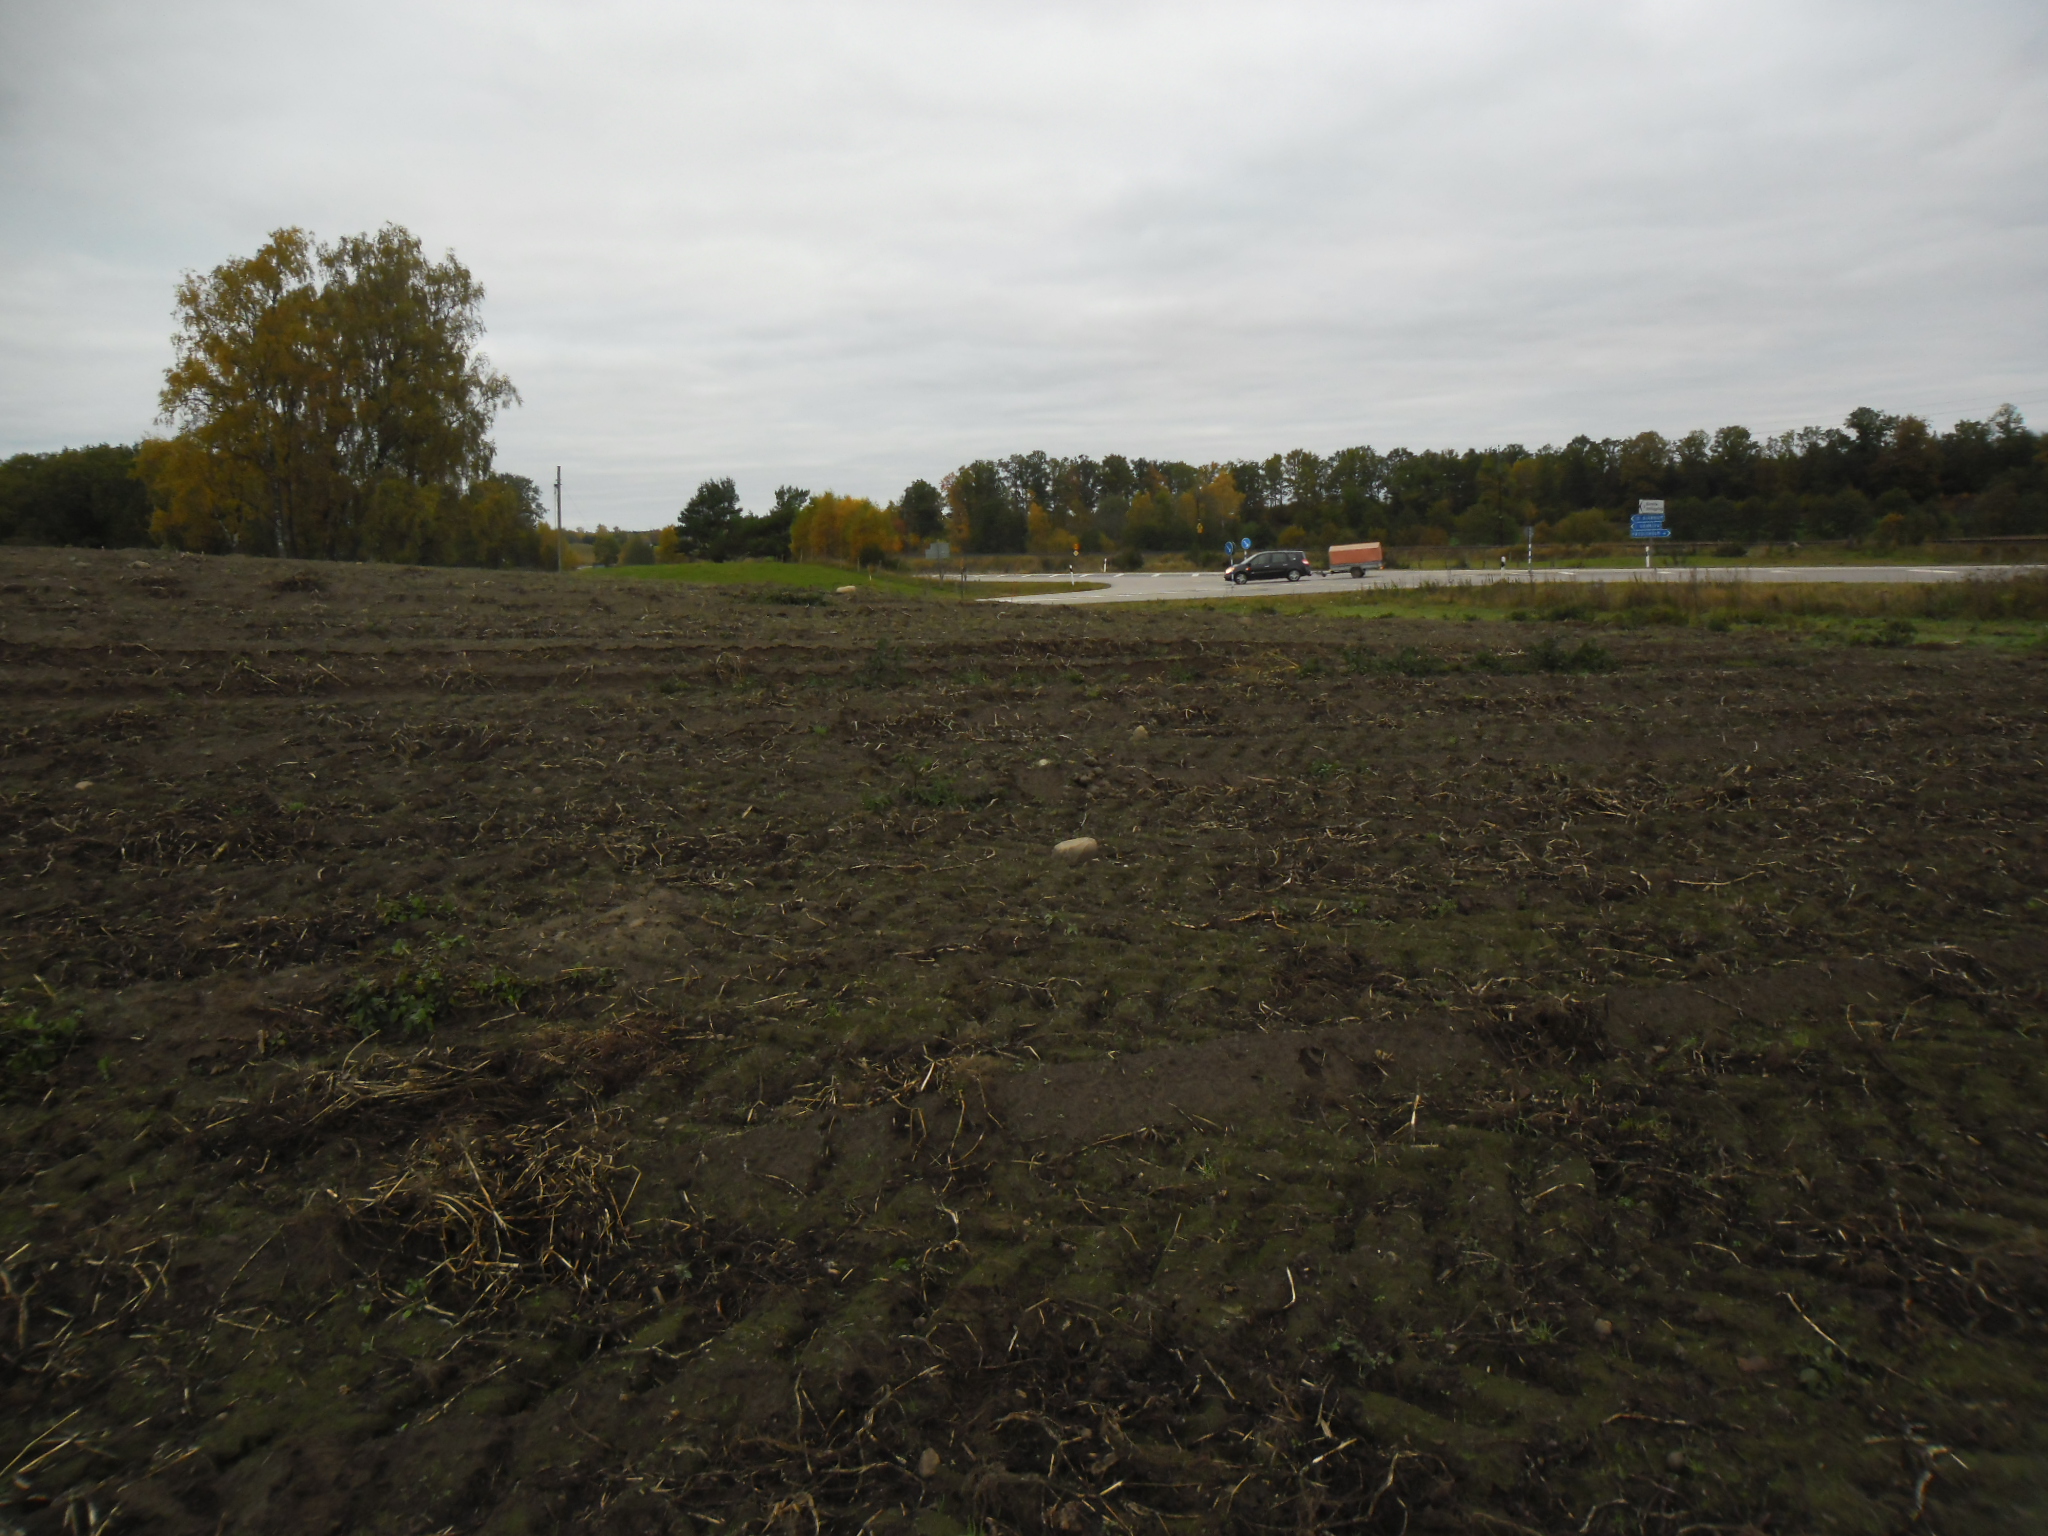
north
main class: Cropland
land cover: Potatoes
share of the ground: < 10 %
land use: Agriculture (excluding fallow land and kitchen gardens)
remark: Harvested field
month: October
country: SE
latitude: 56.1870
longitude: 13.7517
